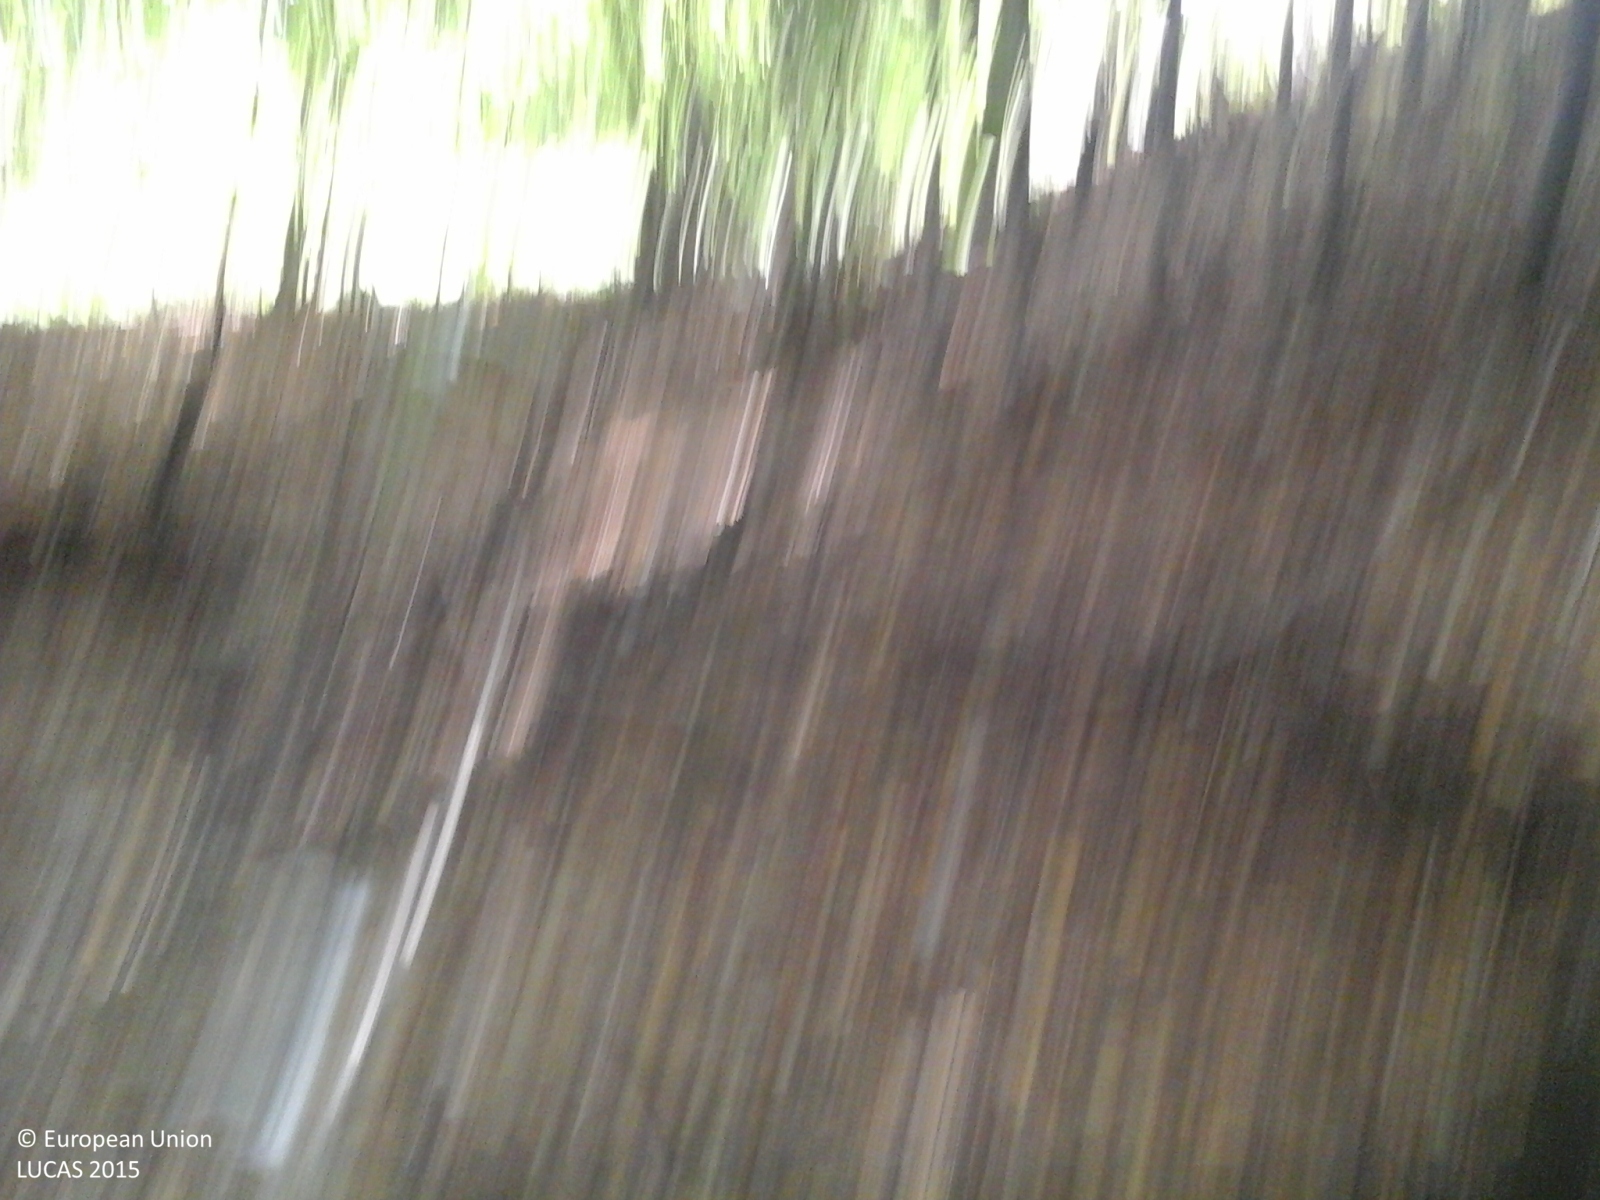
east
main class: Woodland
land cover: Broadleaved woodland
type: thermophilous deciduous forest
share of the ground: > 75 %
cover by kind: broadleaved forest trees 80 %, shrubs 20 %
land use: Semi-natural and natural areas not in use
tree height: > 5 m
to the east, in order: Broadleaved woodland; Grassland with sparse tree/shrub cover; Electric lines; Grassland with sparse tree/shrub cover; Tracks; Broadleaved woodland; Fences; Grassland with sparse tree/shrub cover; Broadleaved woodland; Paved roads, cycling and walking lanes; Electric lines; Grassland without tree/shrub cover
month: September
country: IT
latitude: 44.5018
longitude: 8.4814
